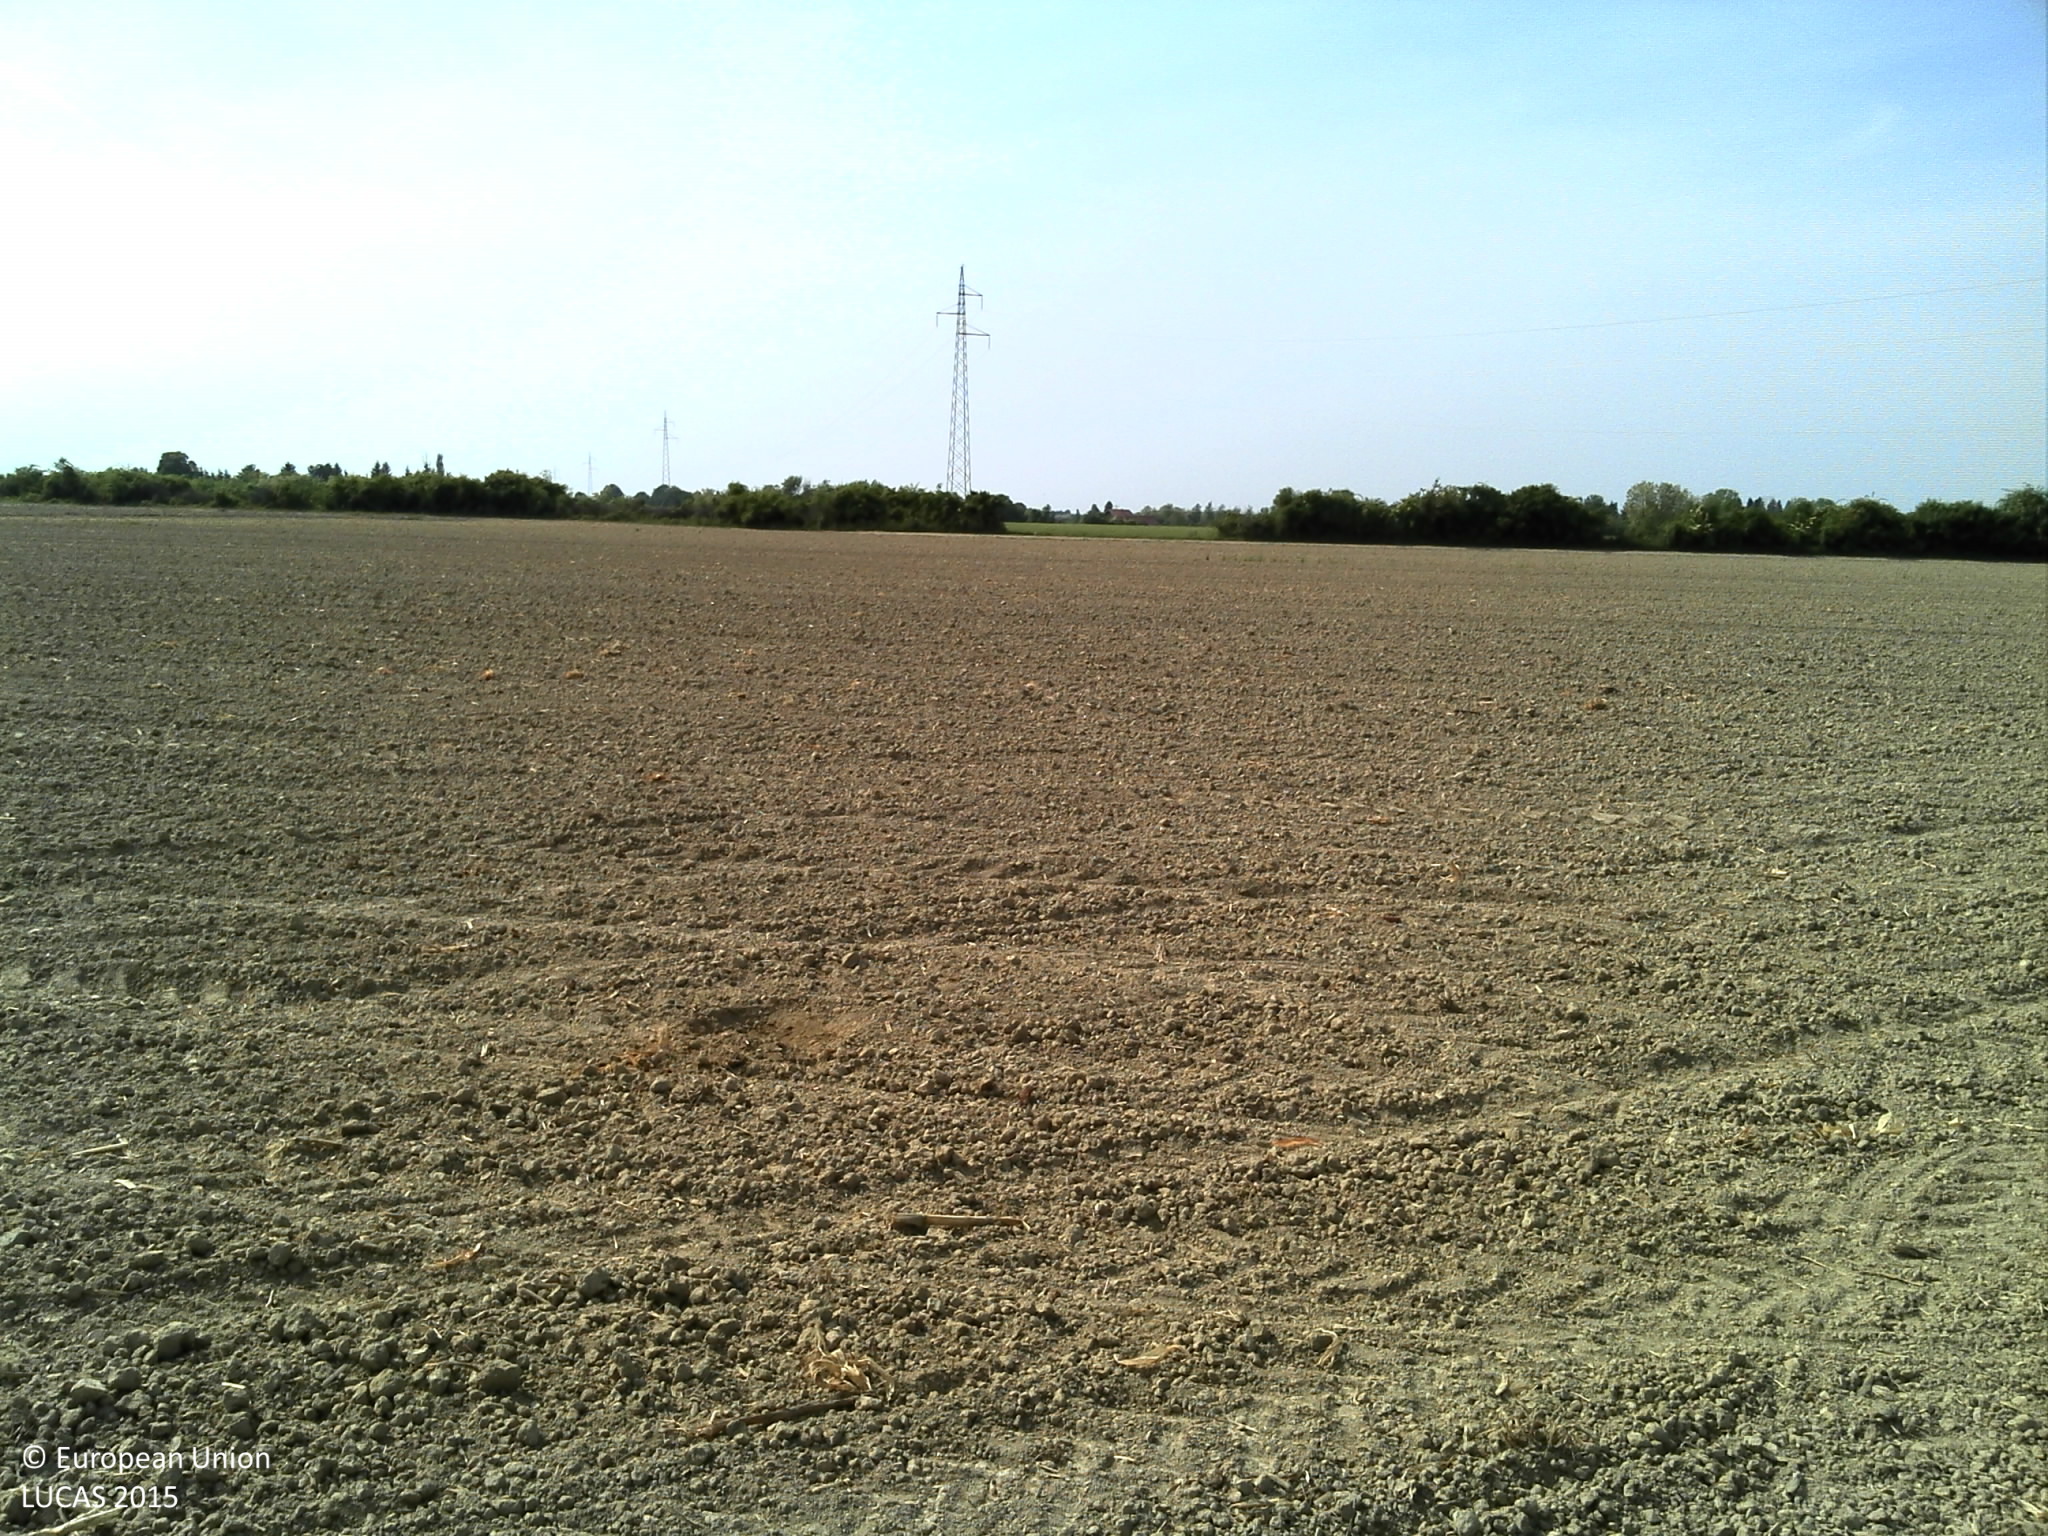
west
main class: Cropland
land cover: Maize
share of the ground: < 10 %
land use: Agriculture (excluding fallow land and kitchen gardens)
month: May
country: HR
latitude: 45.5220
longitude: 18.0570
